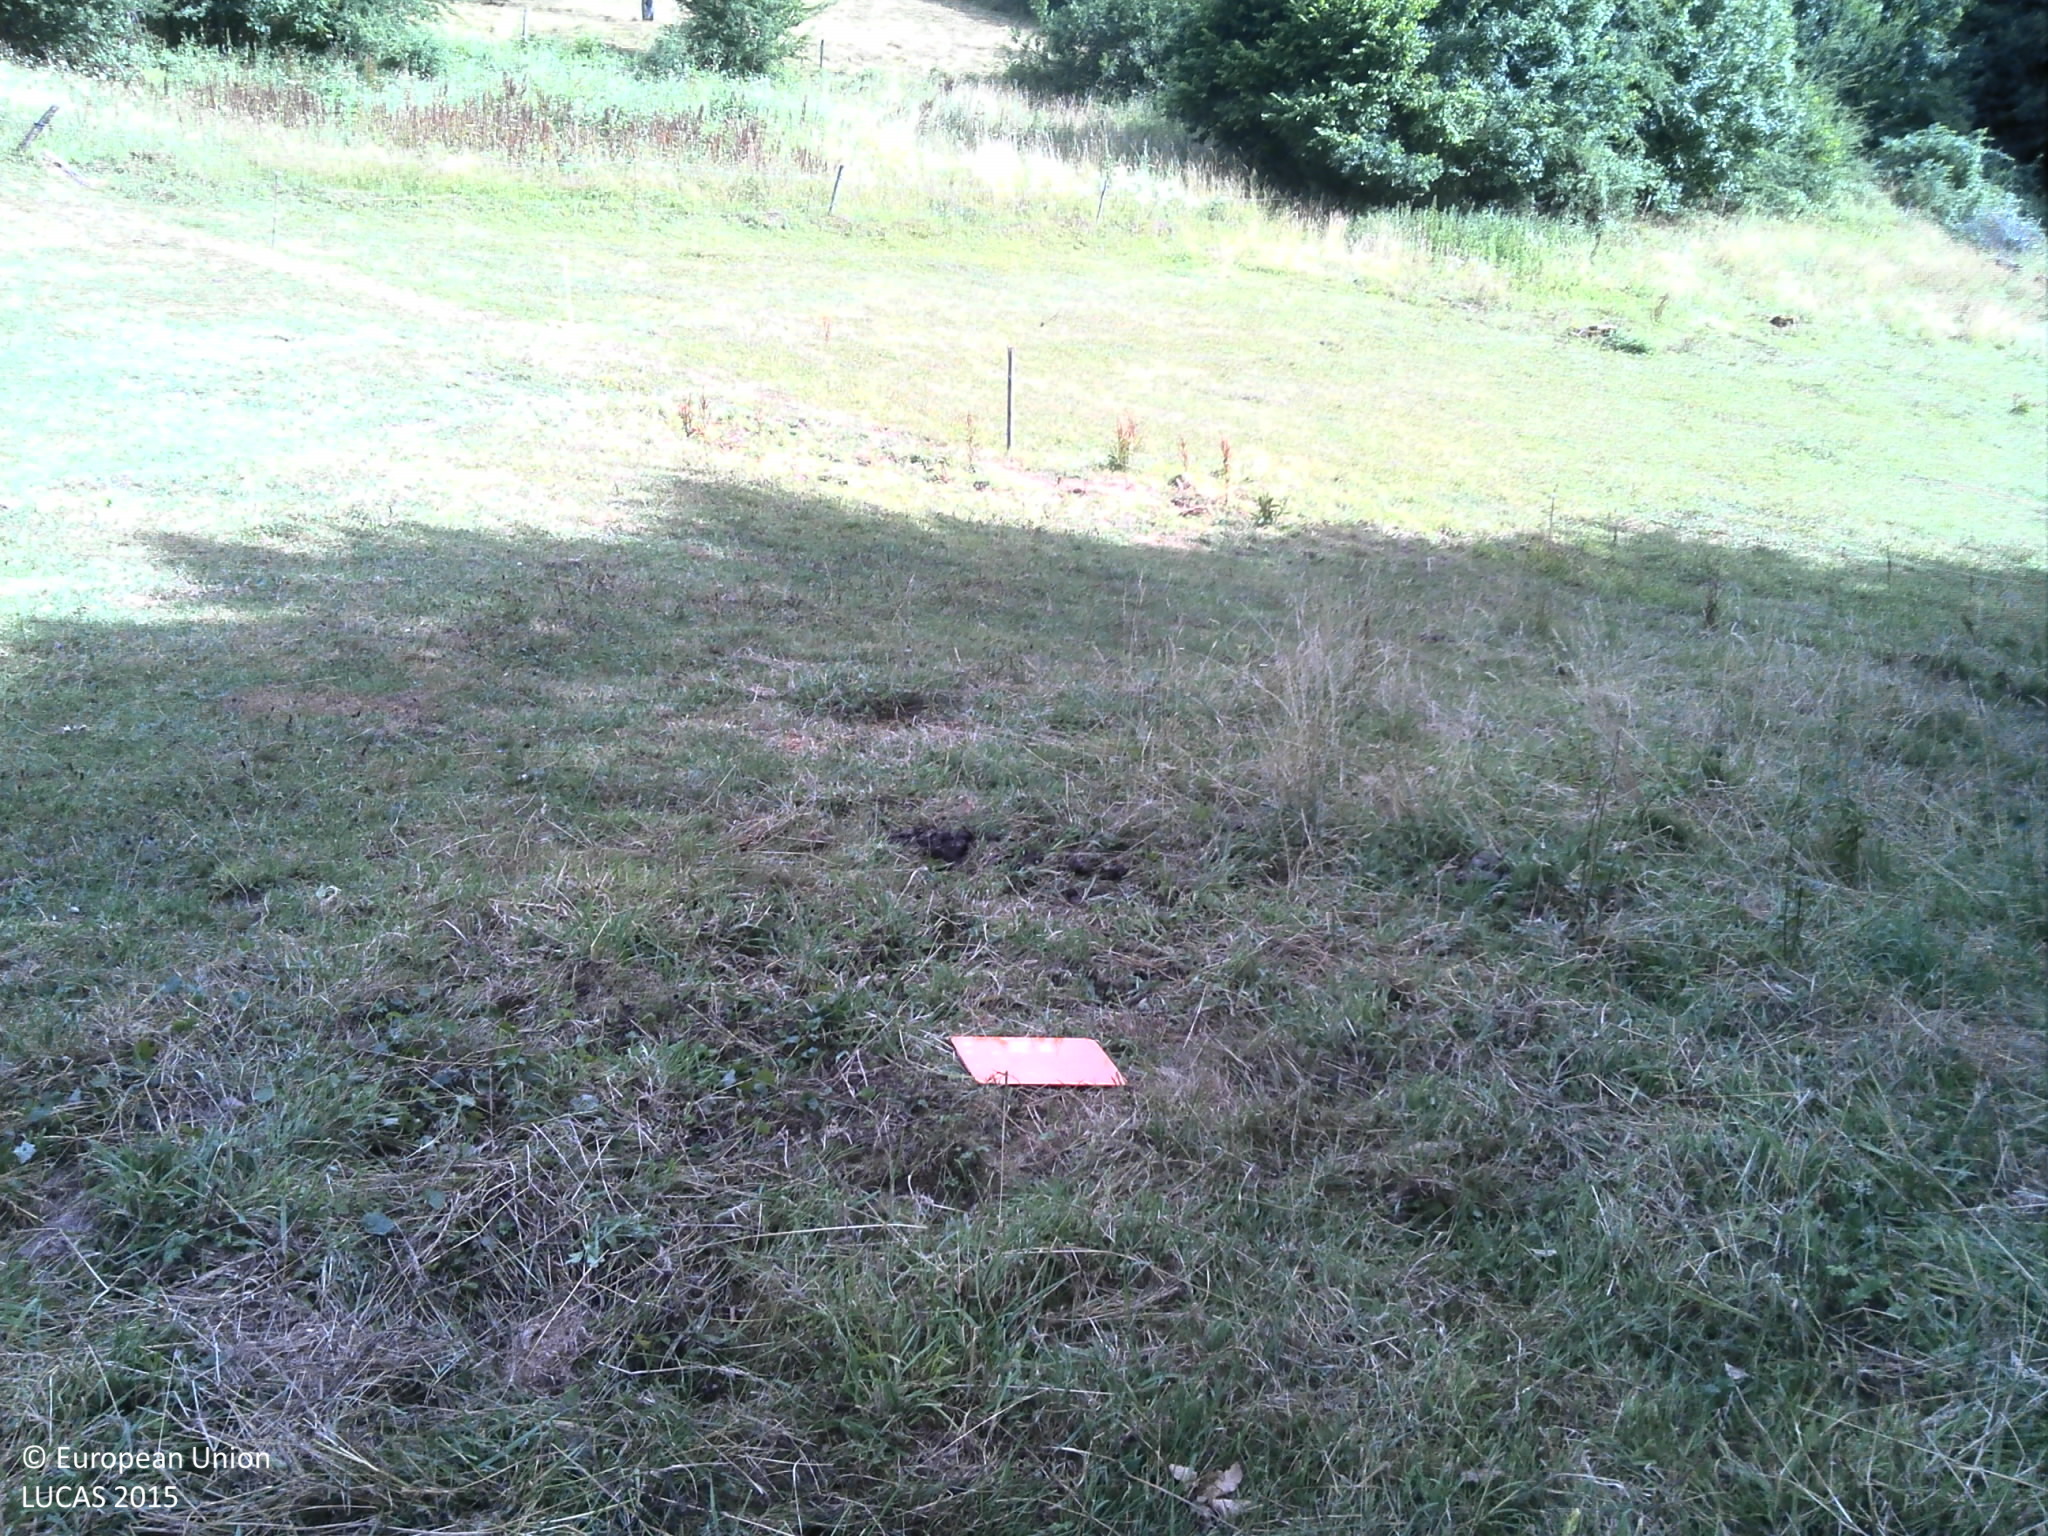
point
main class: Grassland
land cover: Grassland without tree/shrub cover
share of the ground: > 75 %
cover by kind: herbaceous plants 100 %
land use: Agriculture (excluding fallow land and kitchen gardens)
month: July
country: FR
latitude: 49.0740
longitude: 7.3585
